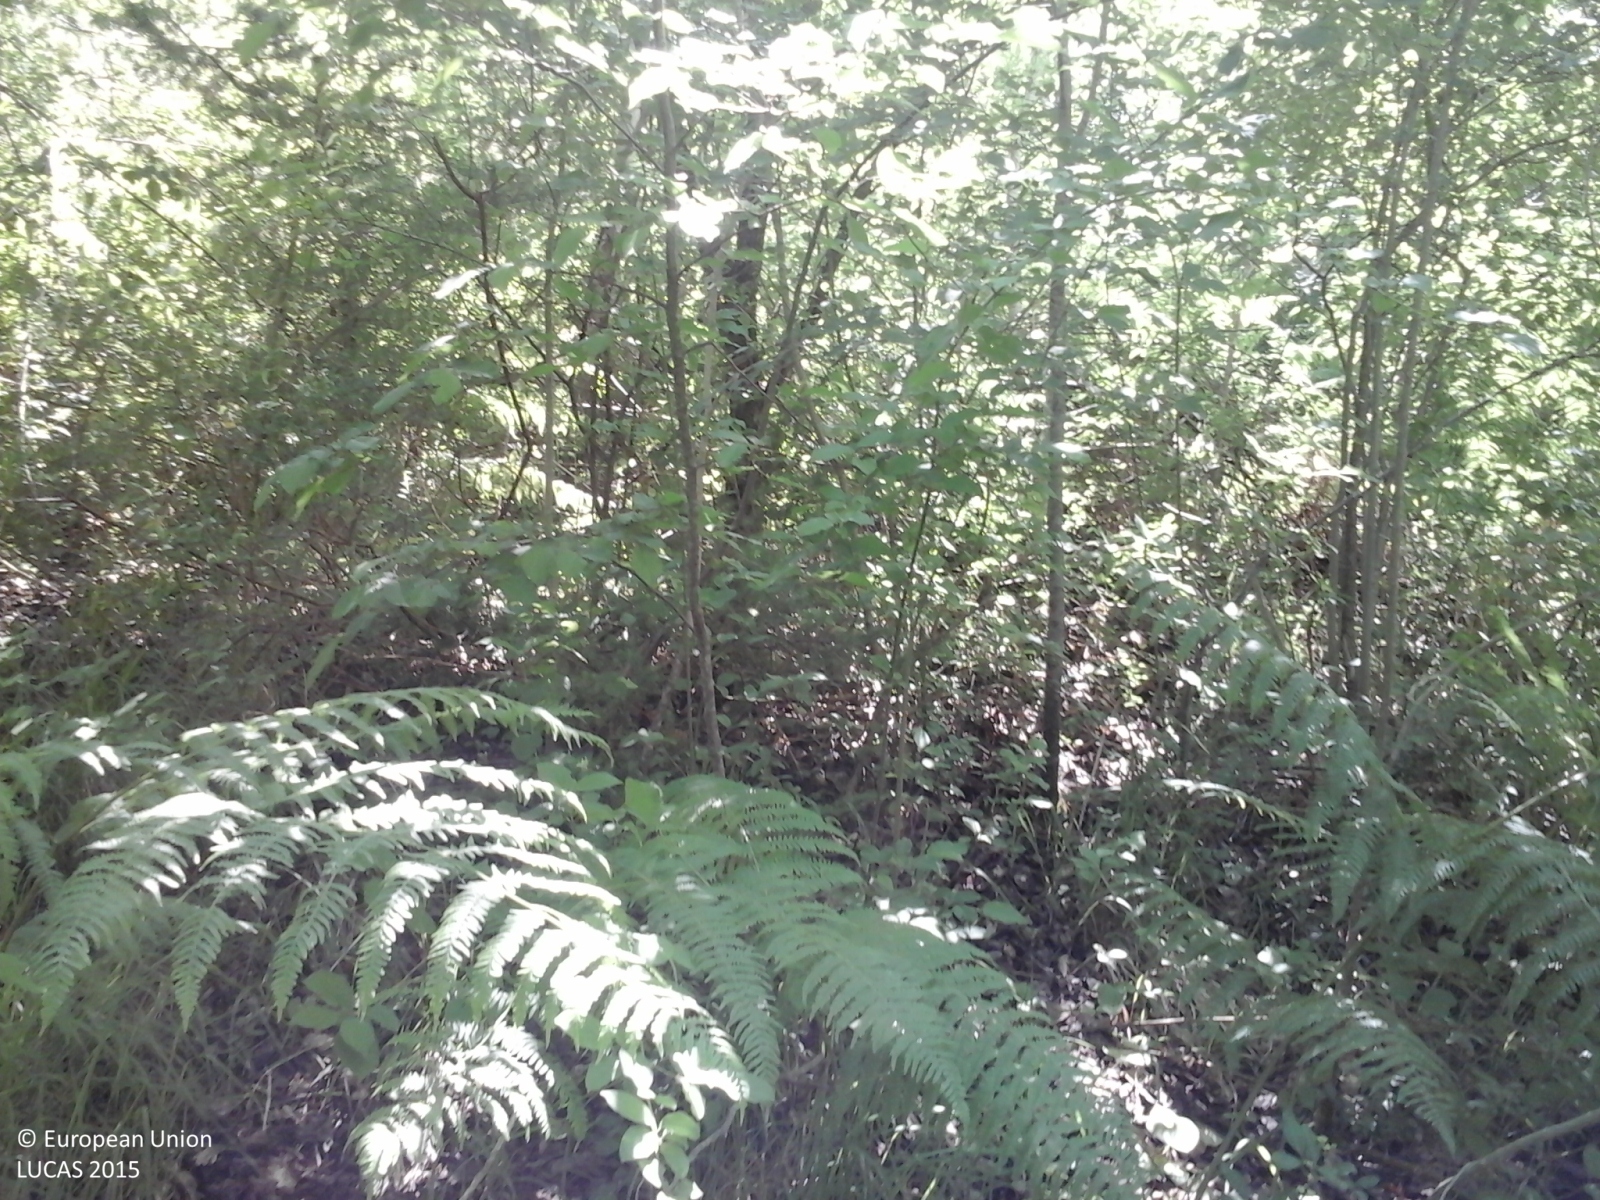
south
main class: Woodland
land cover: Broadleaved woodland
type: thermophilous deciduous forest
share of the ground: > 75 %
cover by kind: broadleaved forest trees 80 %, shrubs 10 %, herbaceous plants 10 %
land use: Abandoned areas
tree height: > 5 m
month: June
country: IT
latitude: 41.9120
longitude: 14.2898
